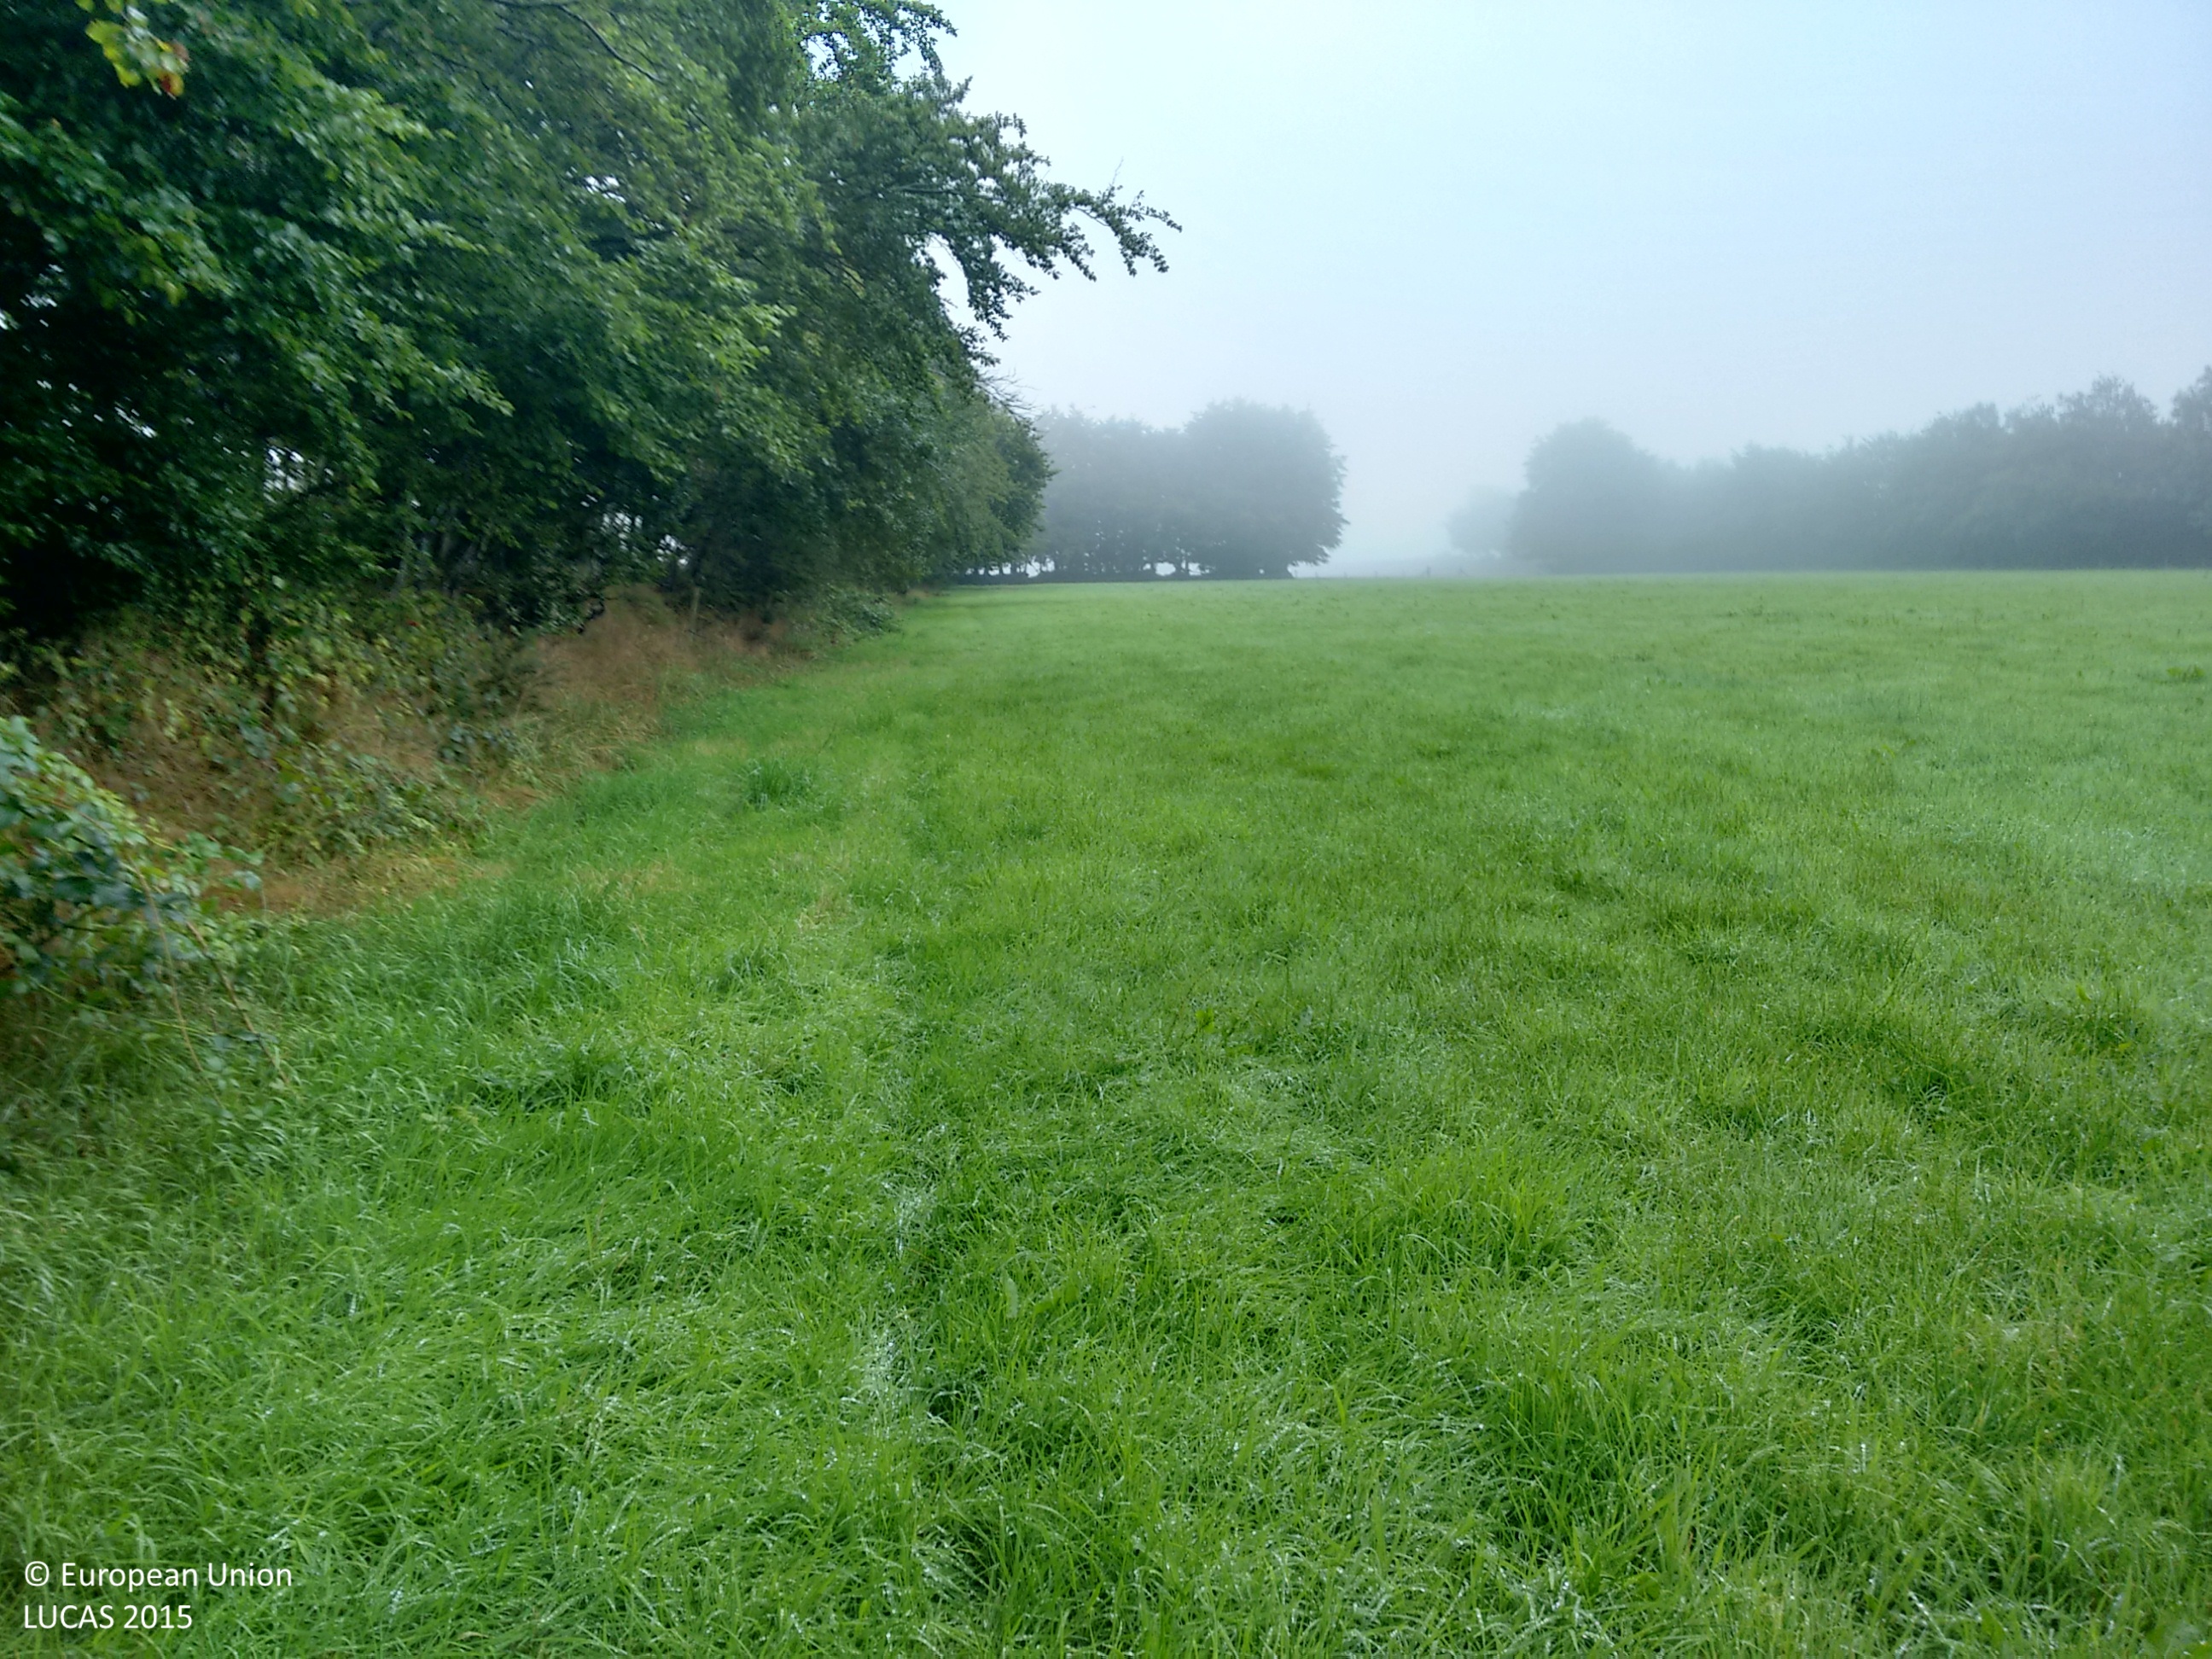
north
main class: Cropland
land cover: Temporary grasslands
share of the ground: > 75 %
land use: Agriculture (excluding fallow land and kitchen gardens)
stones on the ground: < 10 %
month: August
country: GB
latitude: 50.9451
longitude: -3.1867
